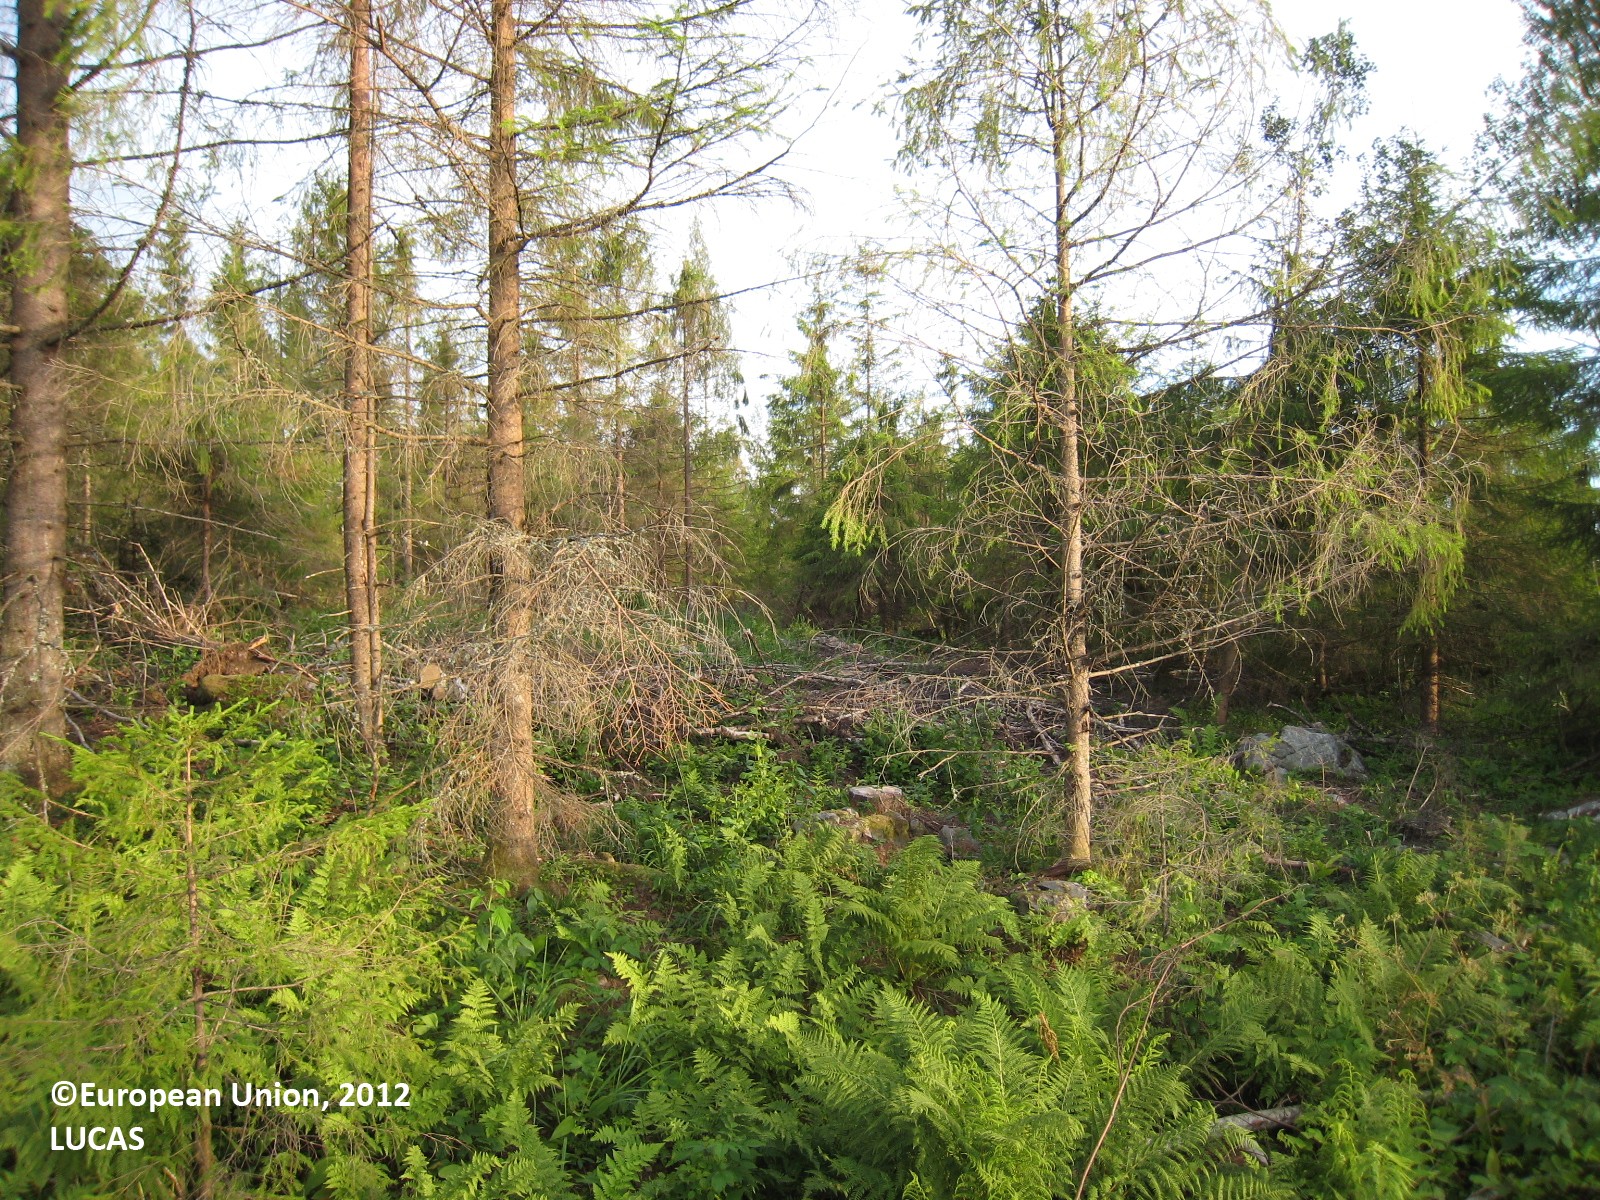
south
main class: Woodland
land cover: Spruce dominated coniferous woodland
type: boreal forest
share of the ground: 25 - 50 %
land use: Forestry
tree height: > 5 m
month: July
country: FI
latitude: 63.1636
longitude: 26.9195
